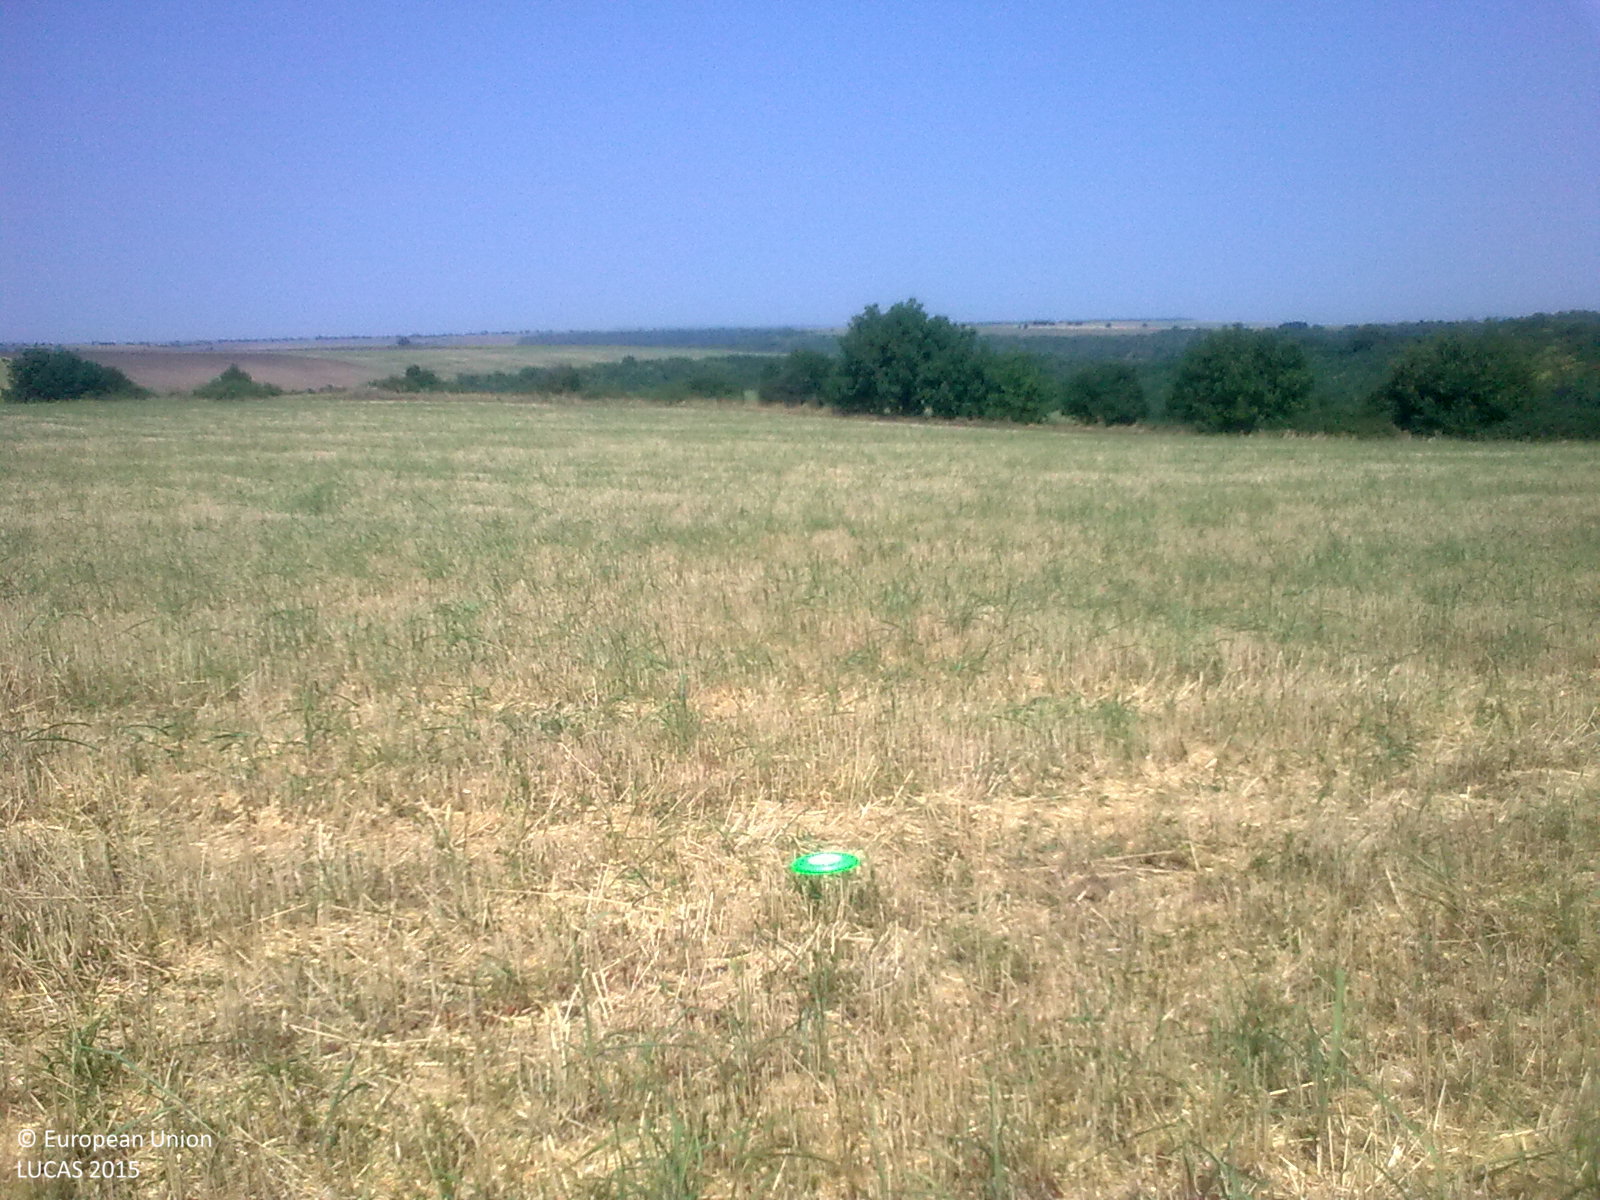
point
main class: Cropland
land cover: Common wheat
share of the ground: 50 - 75 %
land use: Agriculture (excluding fallow land and kitchen gardens)
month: July
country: BG
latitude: 43.6025
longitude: 25.8358
